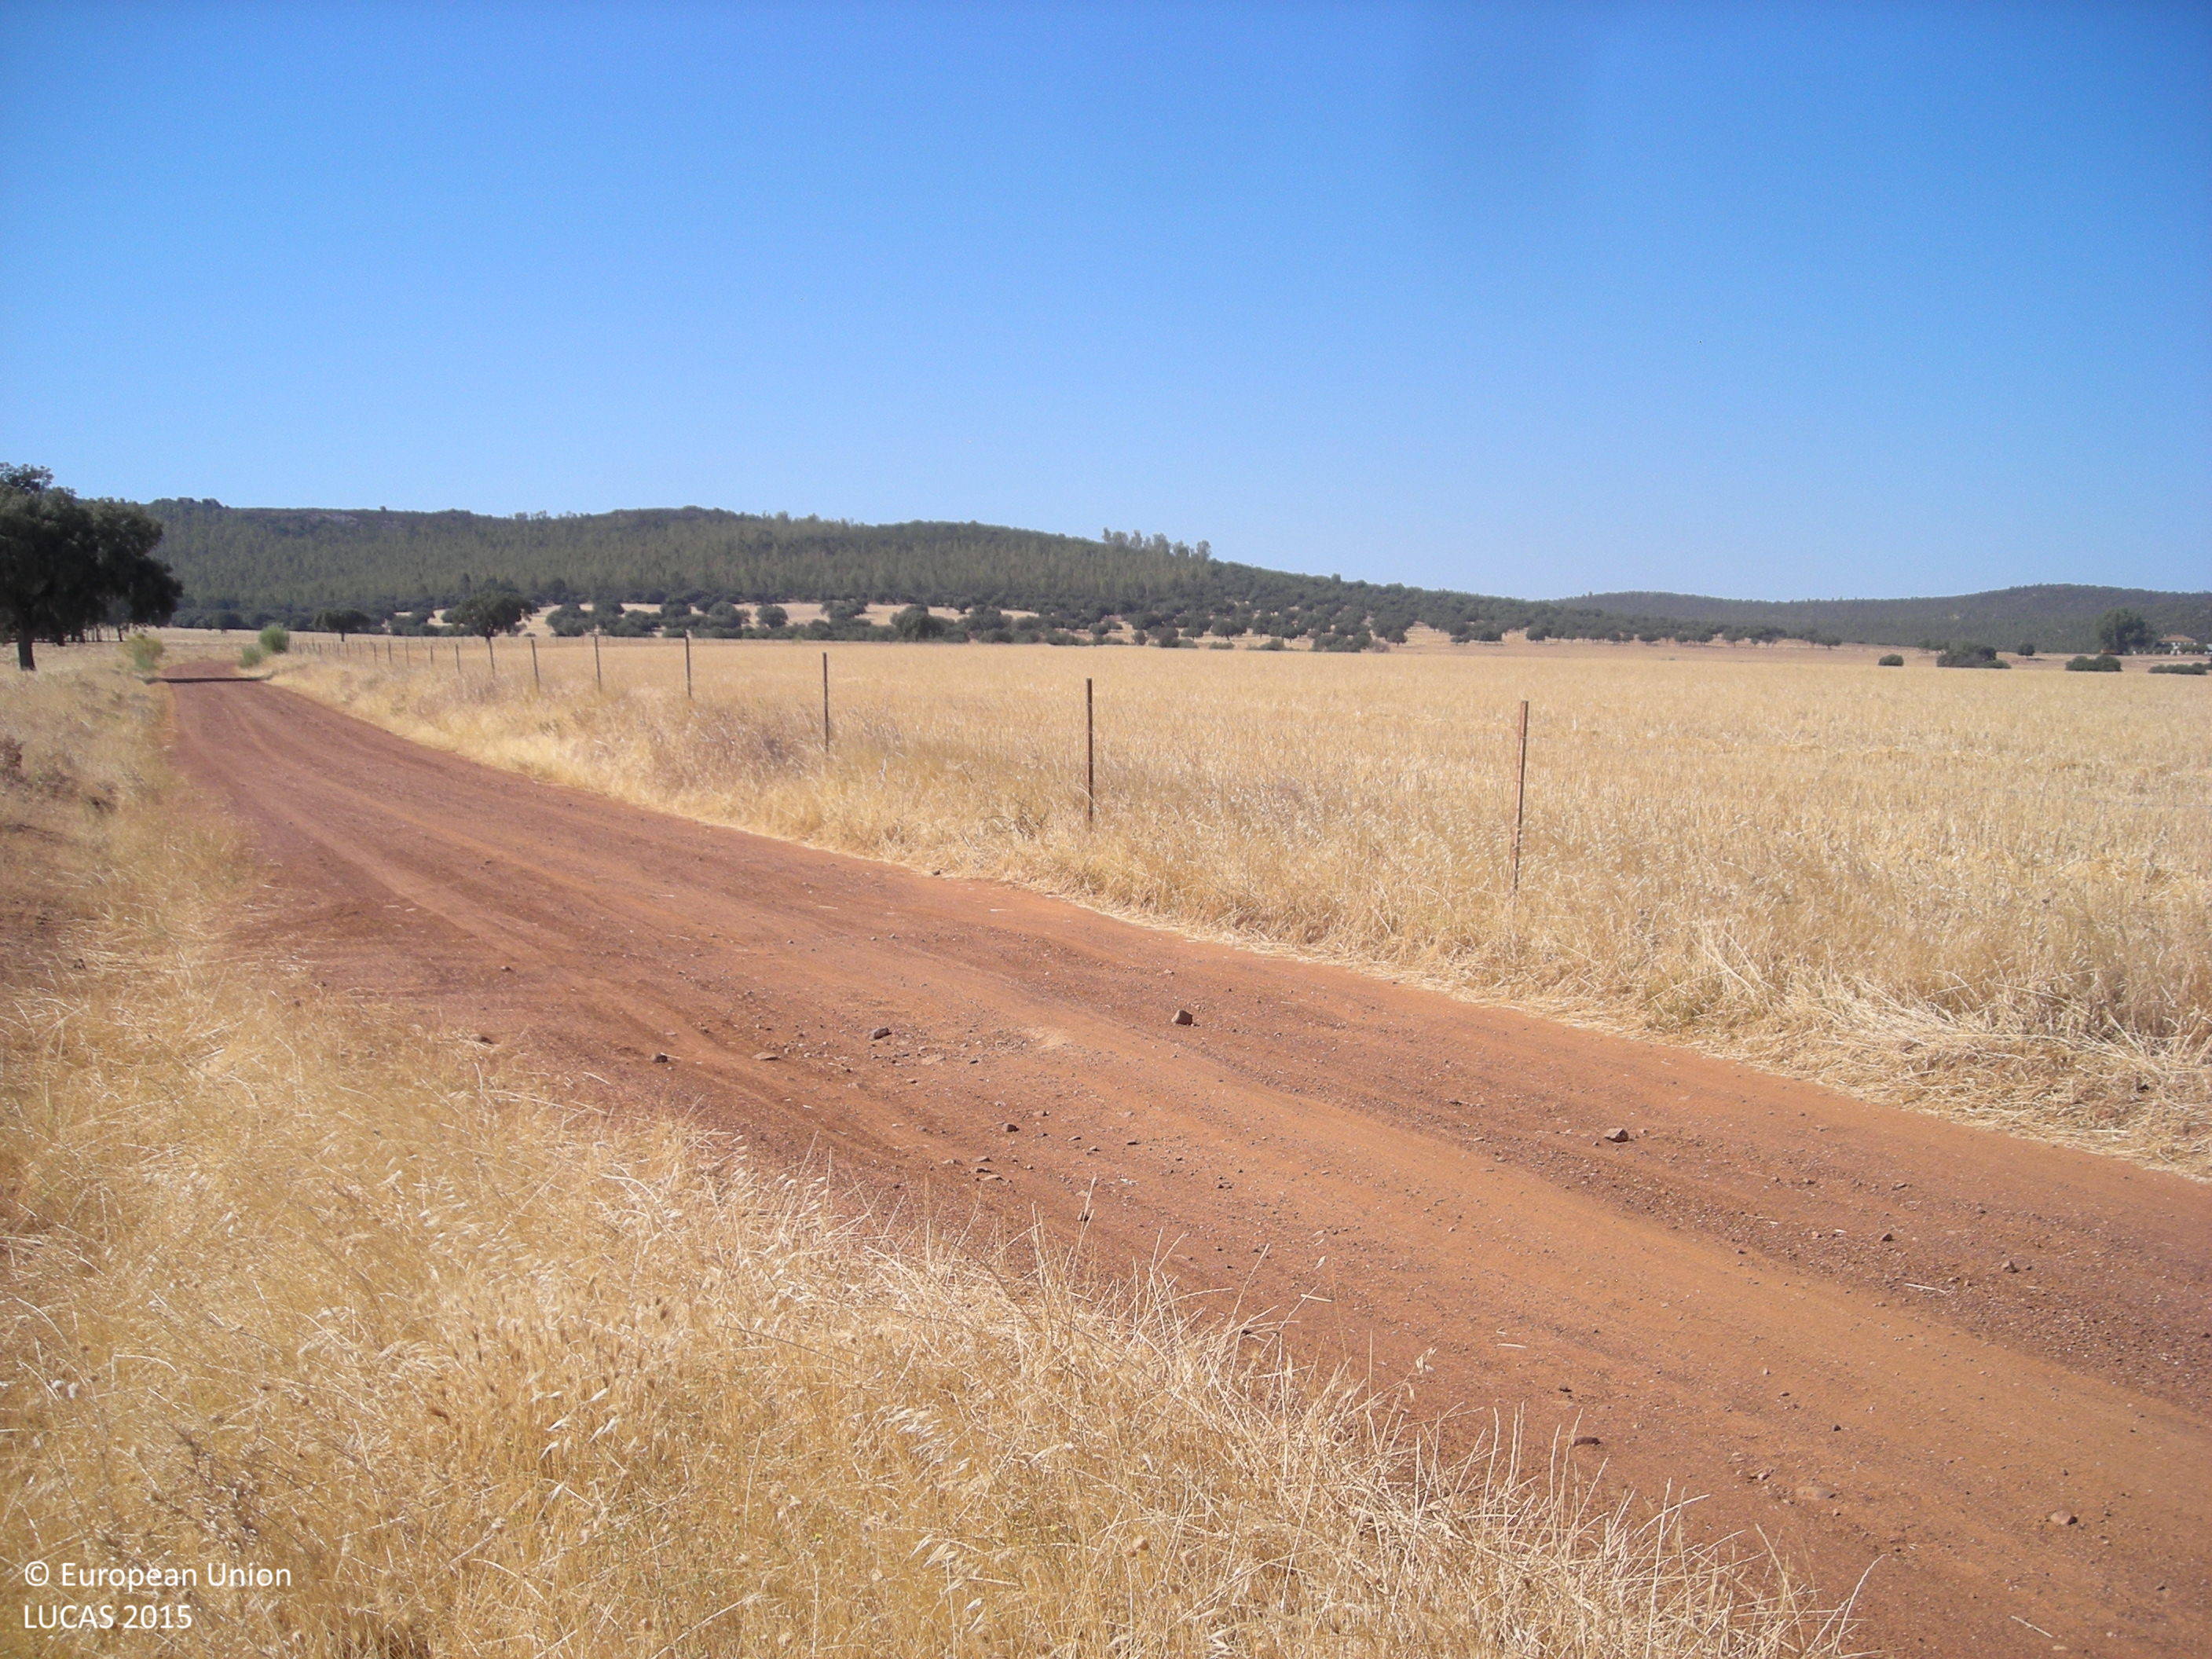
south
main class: Cropland
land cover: Olive groves
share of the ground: 10 - 25 %
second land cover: Other bare soil
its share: > 75 %
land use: Agriculture (excluding fallow land and kitchen gardens)
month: July
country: ES
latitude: 38.8244
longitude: -5.8382
